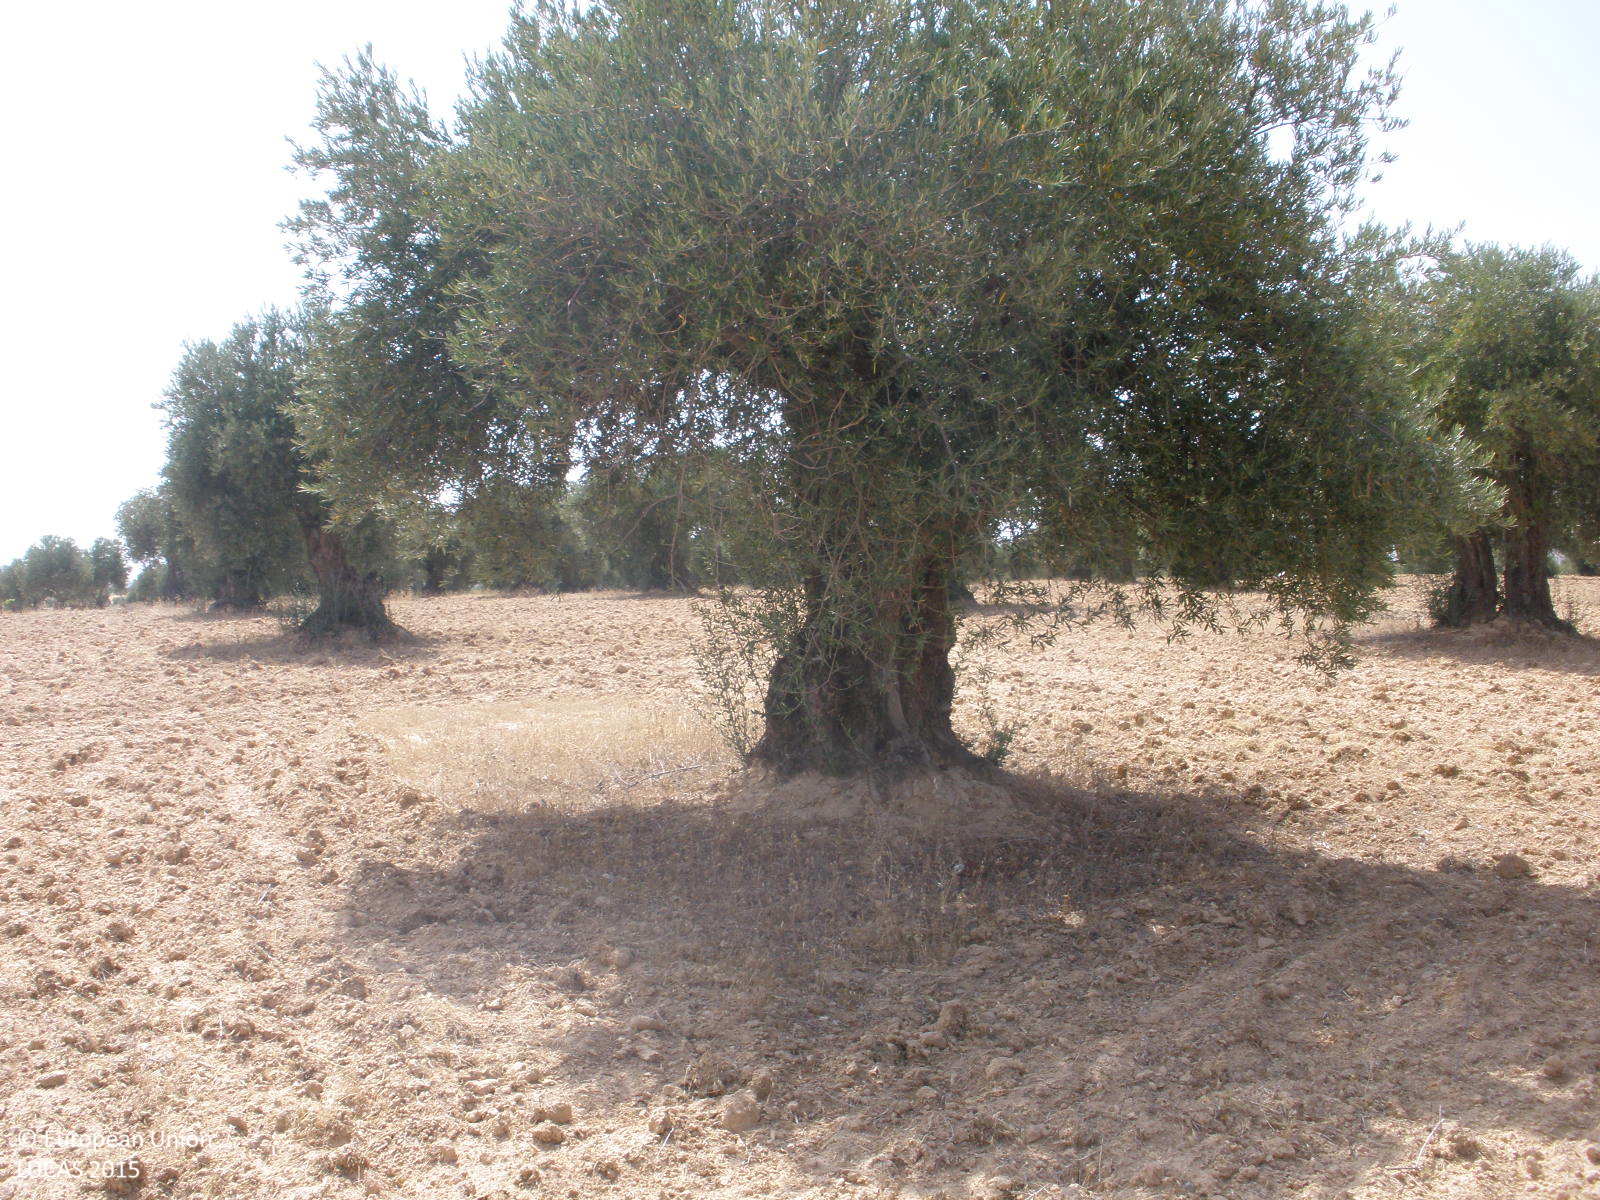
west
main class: Cropland
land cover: Olive groves
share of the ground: 25 - 50 %
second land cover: Other bare soil
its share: > 75 %
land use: Agriculture (excluding fallow land and kitchen gardens)
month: July
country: ES
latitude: 40.1605
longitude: -3.4507
